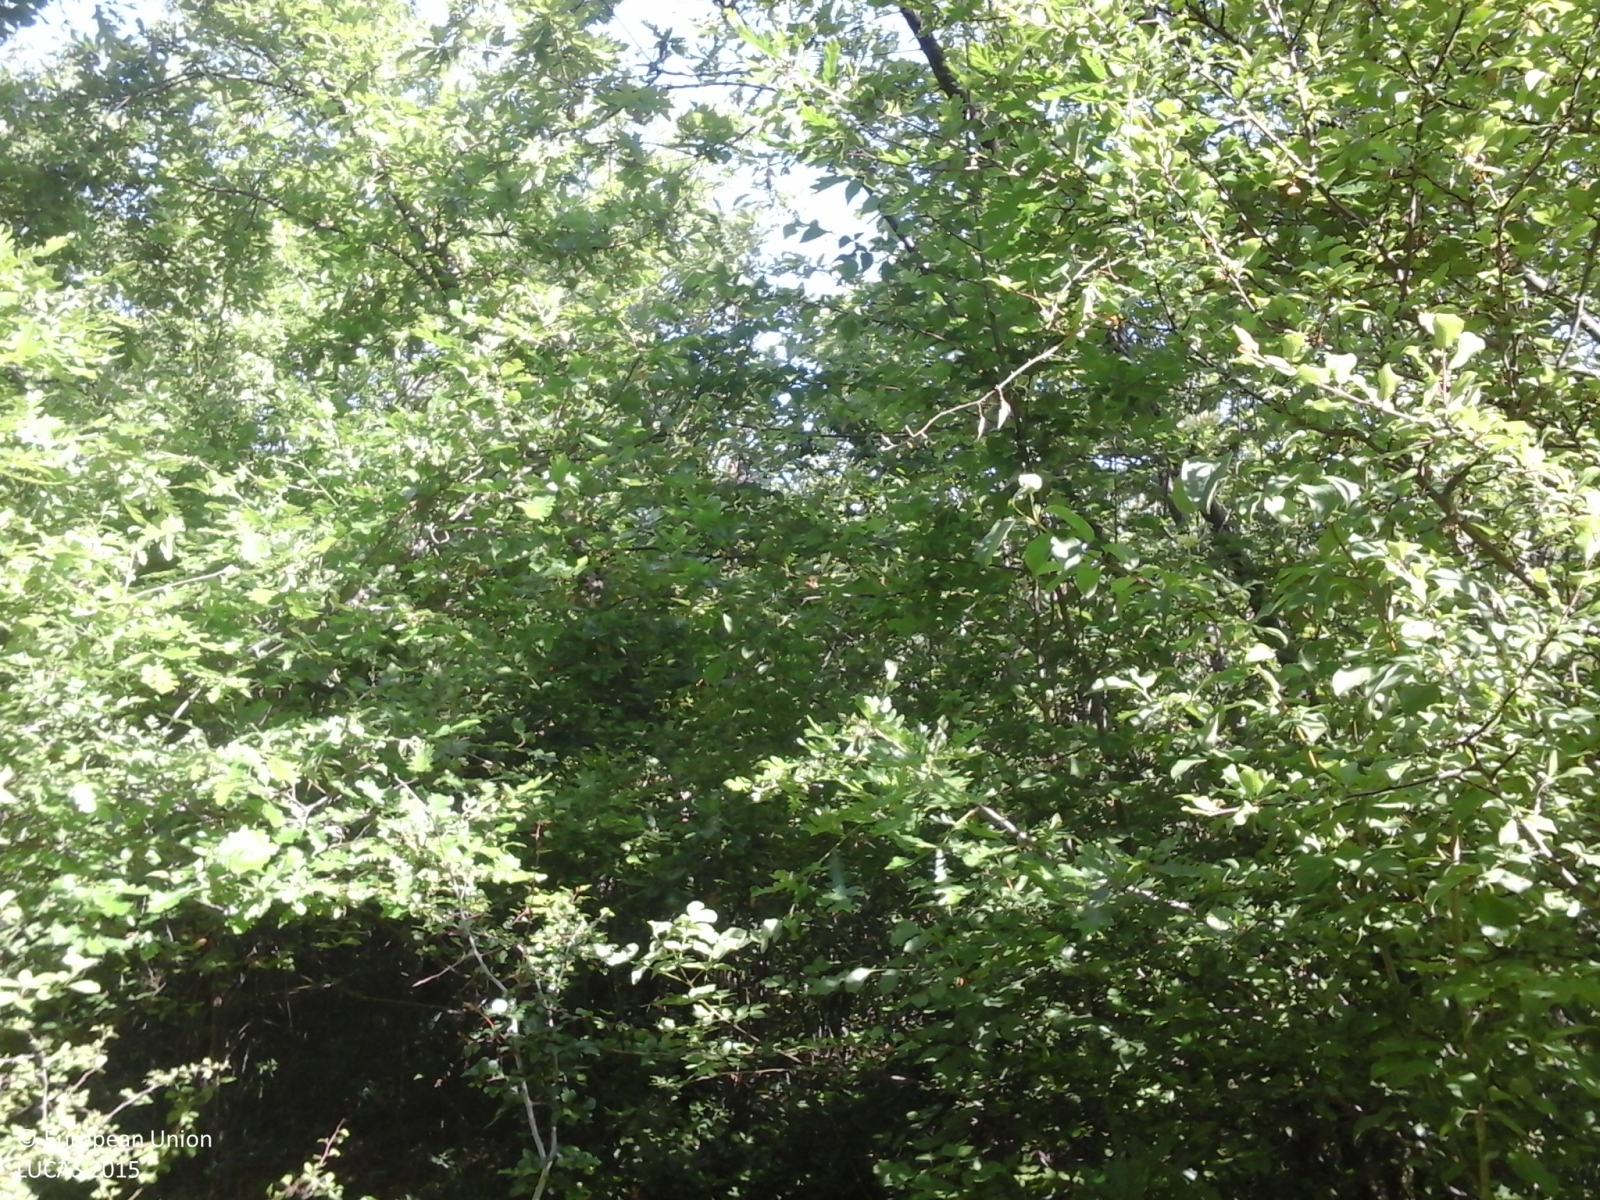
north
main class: Woodland
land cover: Broadleaved woodland
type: mesophytic deciduous forest
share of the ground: > 75 %
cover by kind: broadleaved forest trees 90 %, shrubs 5 %, herbaceous plants 5 %
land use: Forestry
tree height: > 5 m
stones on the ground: < 10 %
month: May
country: IT
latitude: 44.4582
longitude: 9.6614
